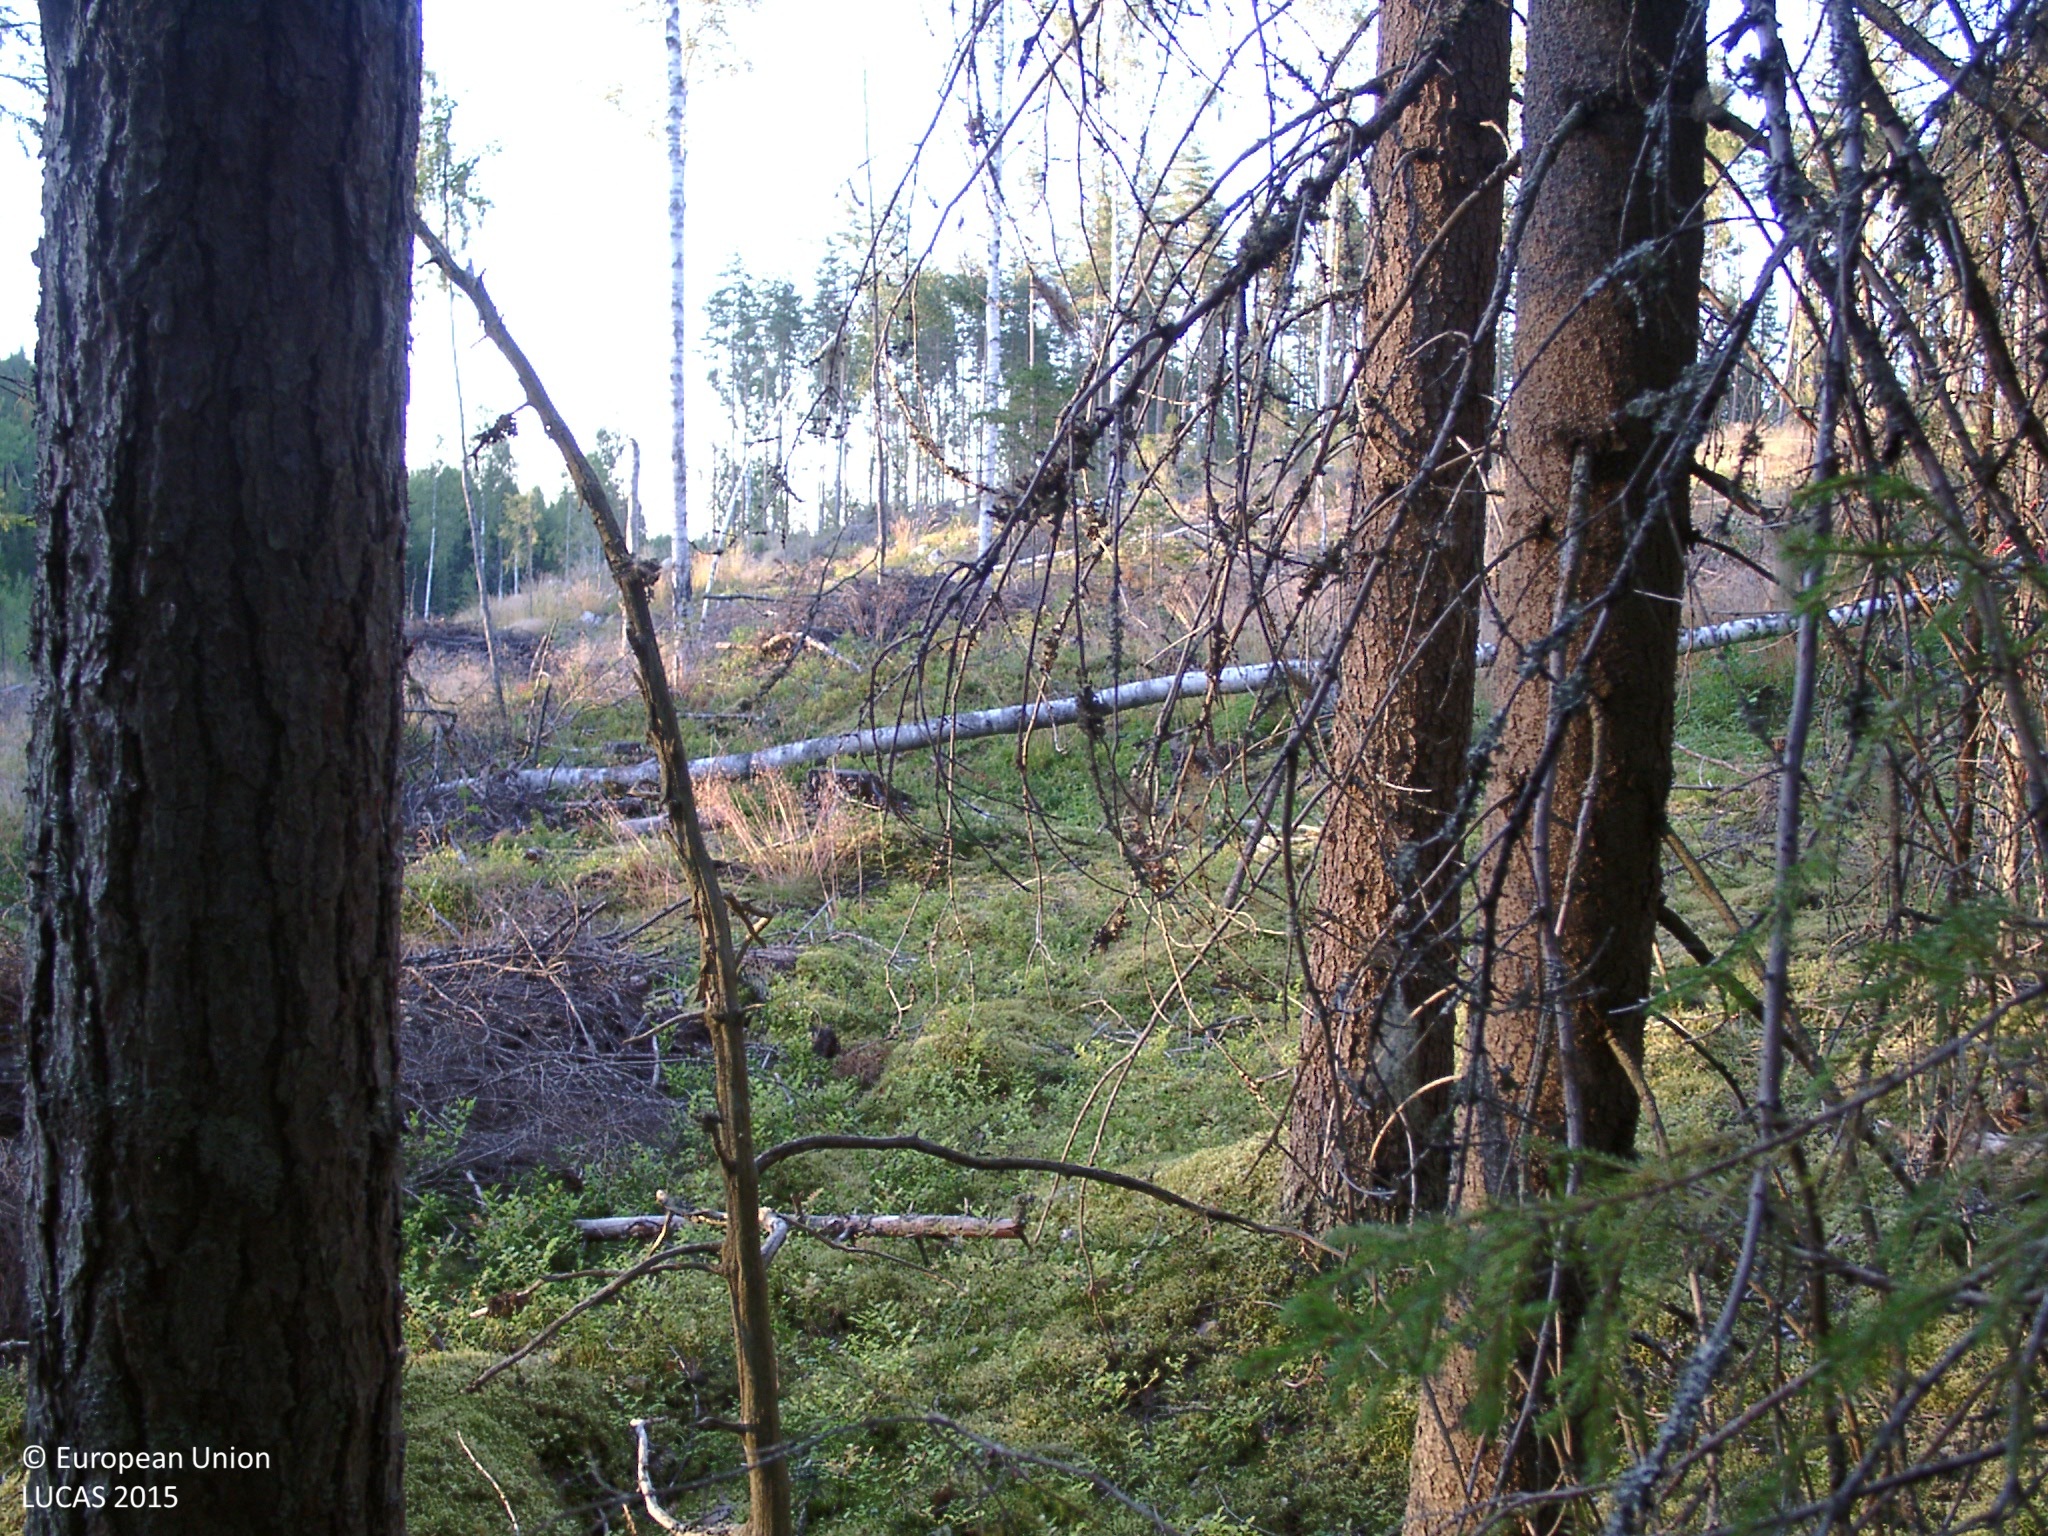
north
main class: Woodland
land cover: Other coniferous woodland
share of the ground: > 75 %
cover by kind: coniferous forest trees 90 %, shrubs 5 %, lichens and mosses 5 %
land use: Forestry
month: August
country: FI
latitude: 61.9711
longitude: 25.1206
